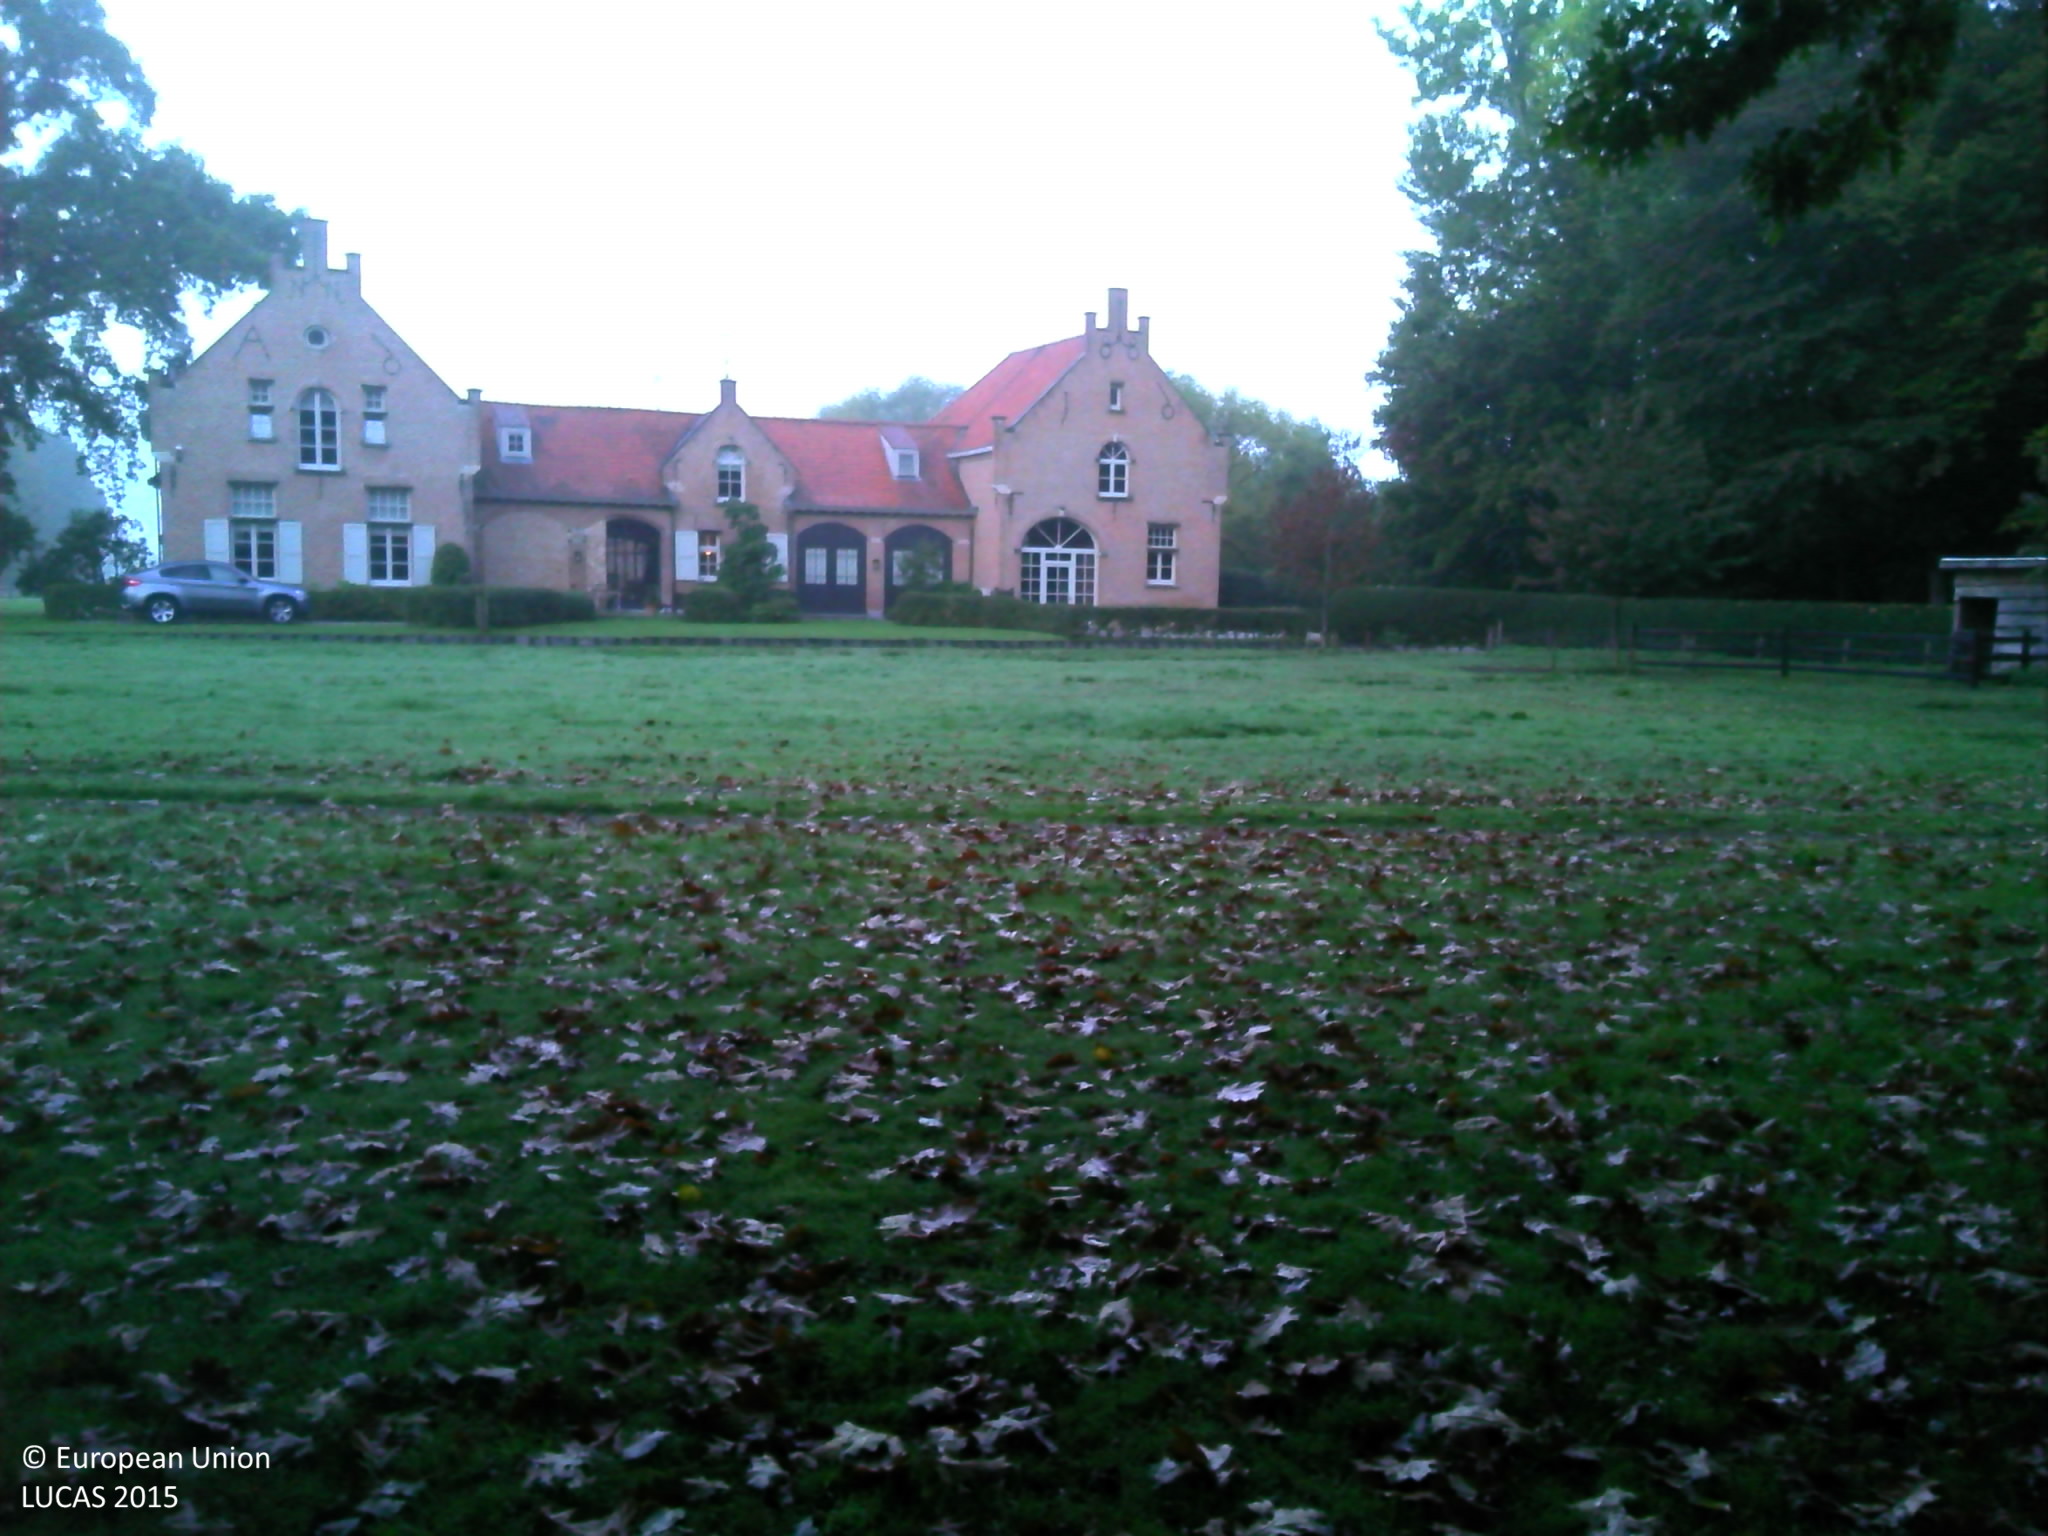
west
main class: Grassland
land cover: Grassland without tree/shrub cover
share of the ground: > 75 %
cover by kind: herbaceous plants 100 %
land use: Residential
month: October
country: BE
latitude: 51.3269
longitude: 4.4129
